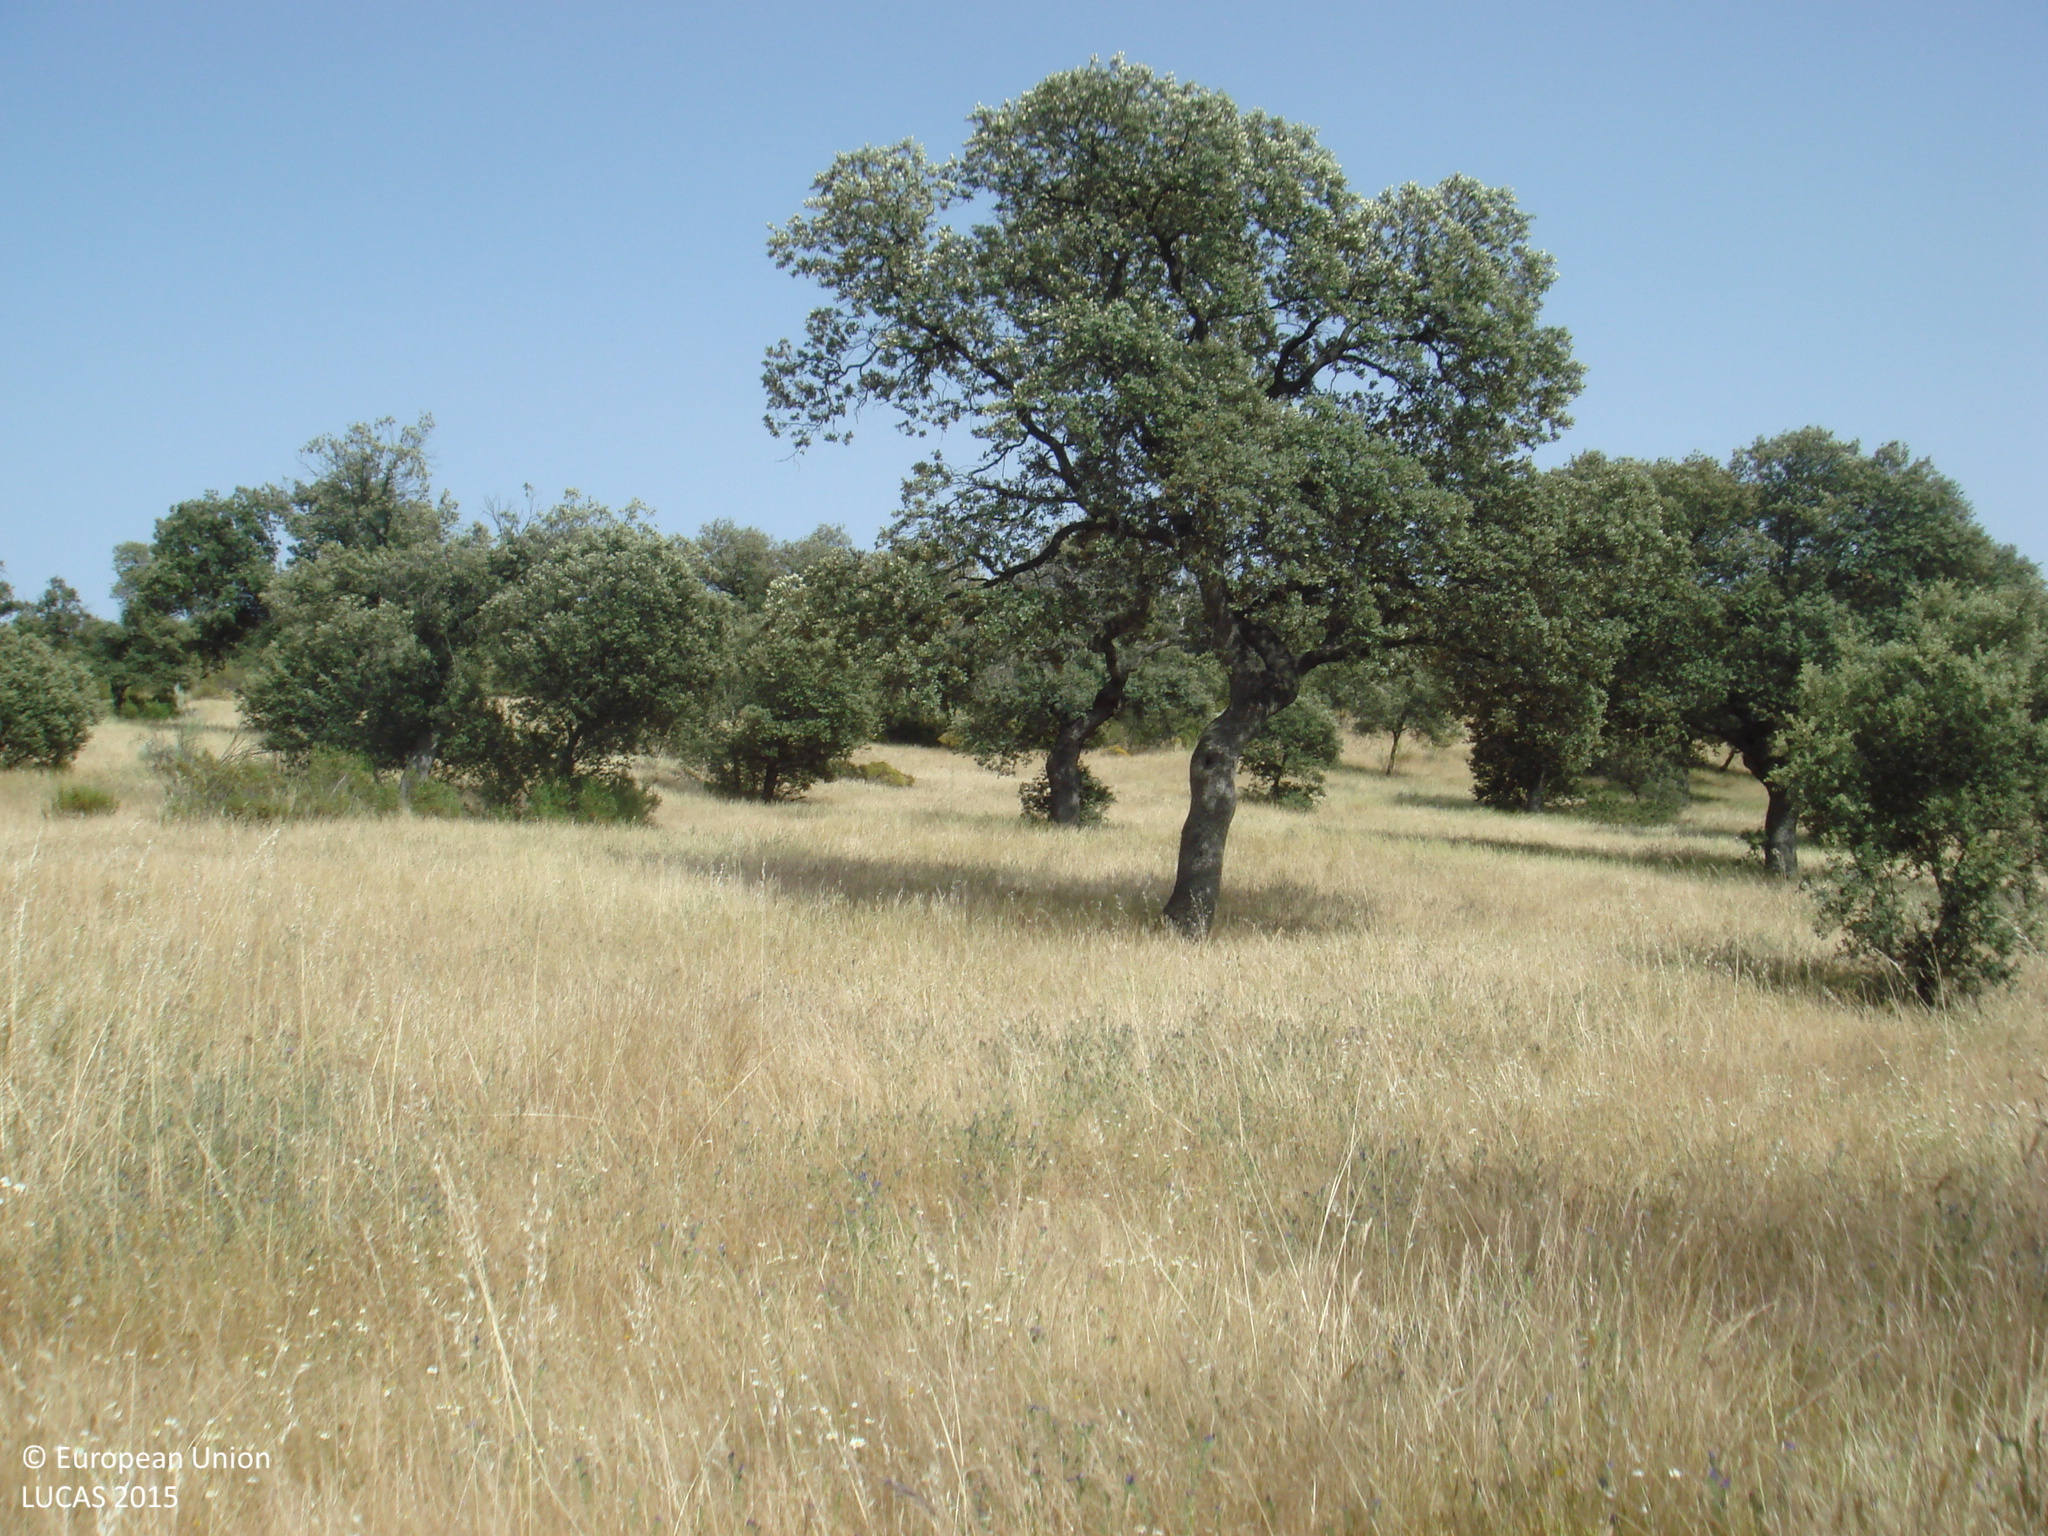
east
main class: Woodland
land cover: Broadleaved woodland
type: broadleaved evergreen forest
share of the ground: 25 - 50 %
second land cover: Spontaneously vegetated surfaces
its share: > 75 %
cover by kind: herbaceous plants 50 %, broadleaved forest trees 40 %, shrubs 10 %
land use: Forestry
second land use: Agriculture (excluding fallow land and kitchen gardens)
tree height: > 5 m
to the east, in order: Broadleaved woodland; Spontaneously vegetated surfaces; Tracks; Broadleaved woodland; Shrubland with sparse tree cover; Tracks; Broadleaved woodland
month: May
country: ES
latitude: 38.5084
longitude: -4.7137
